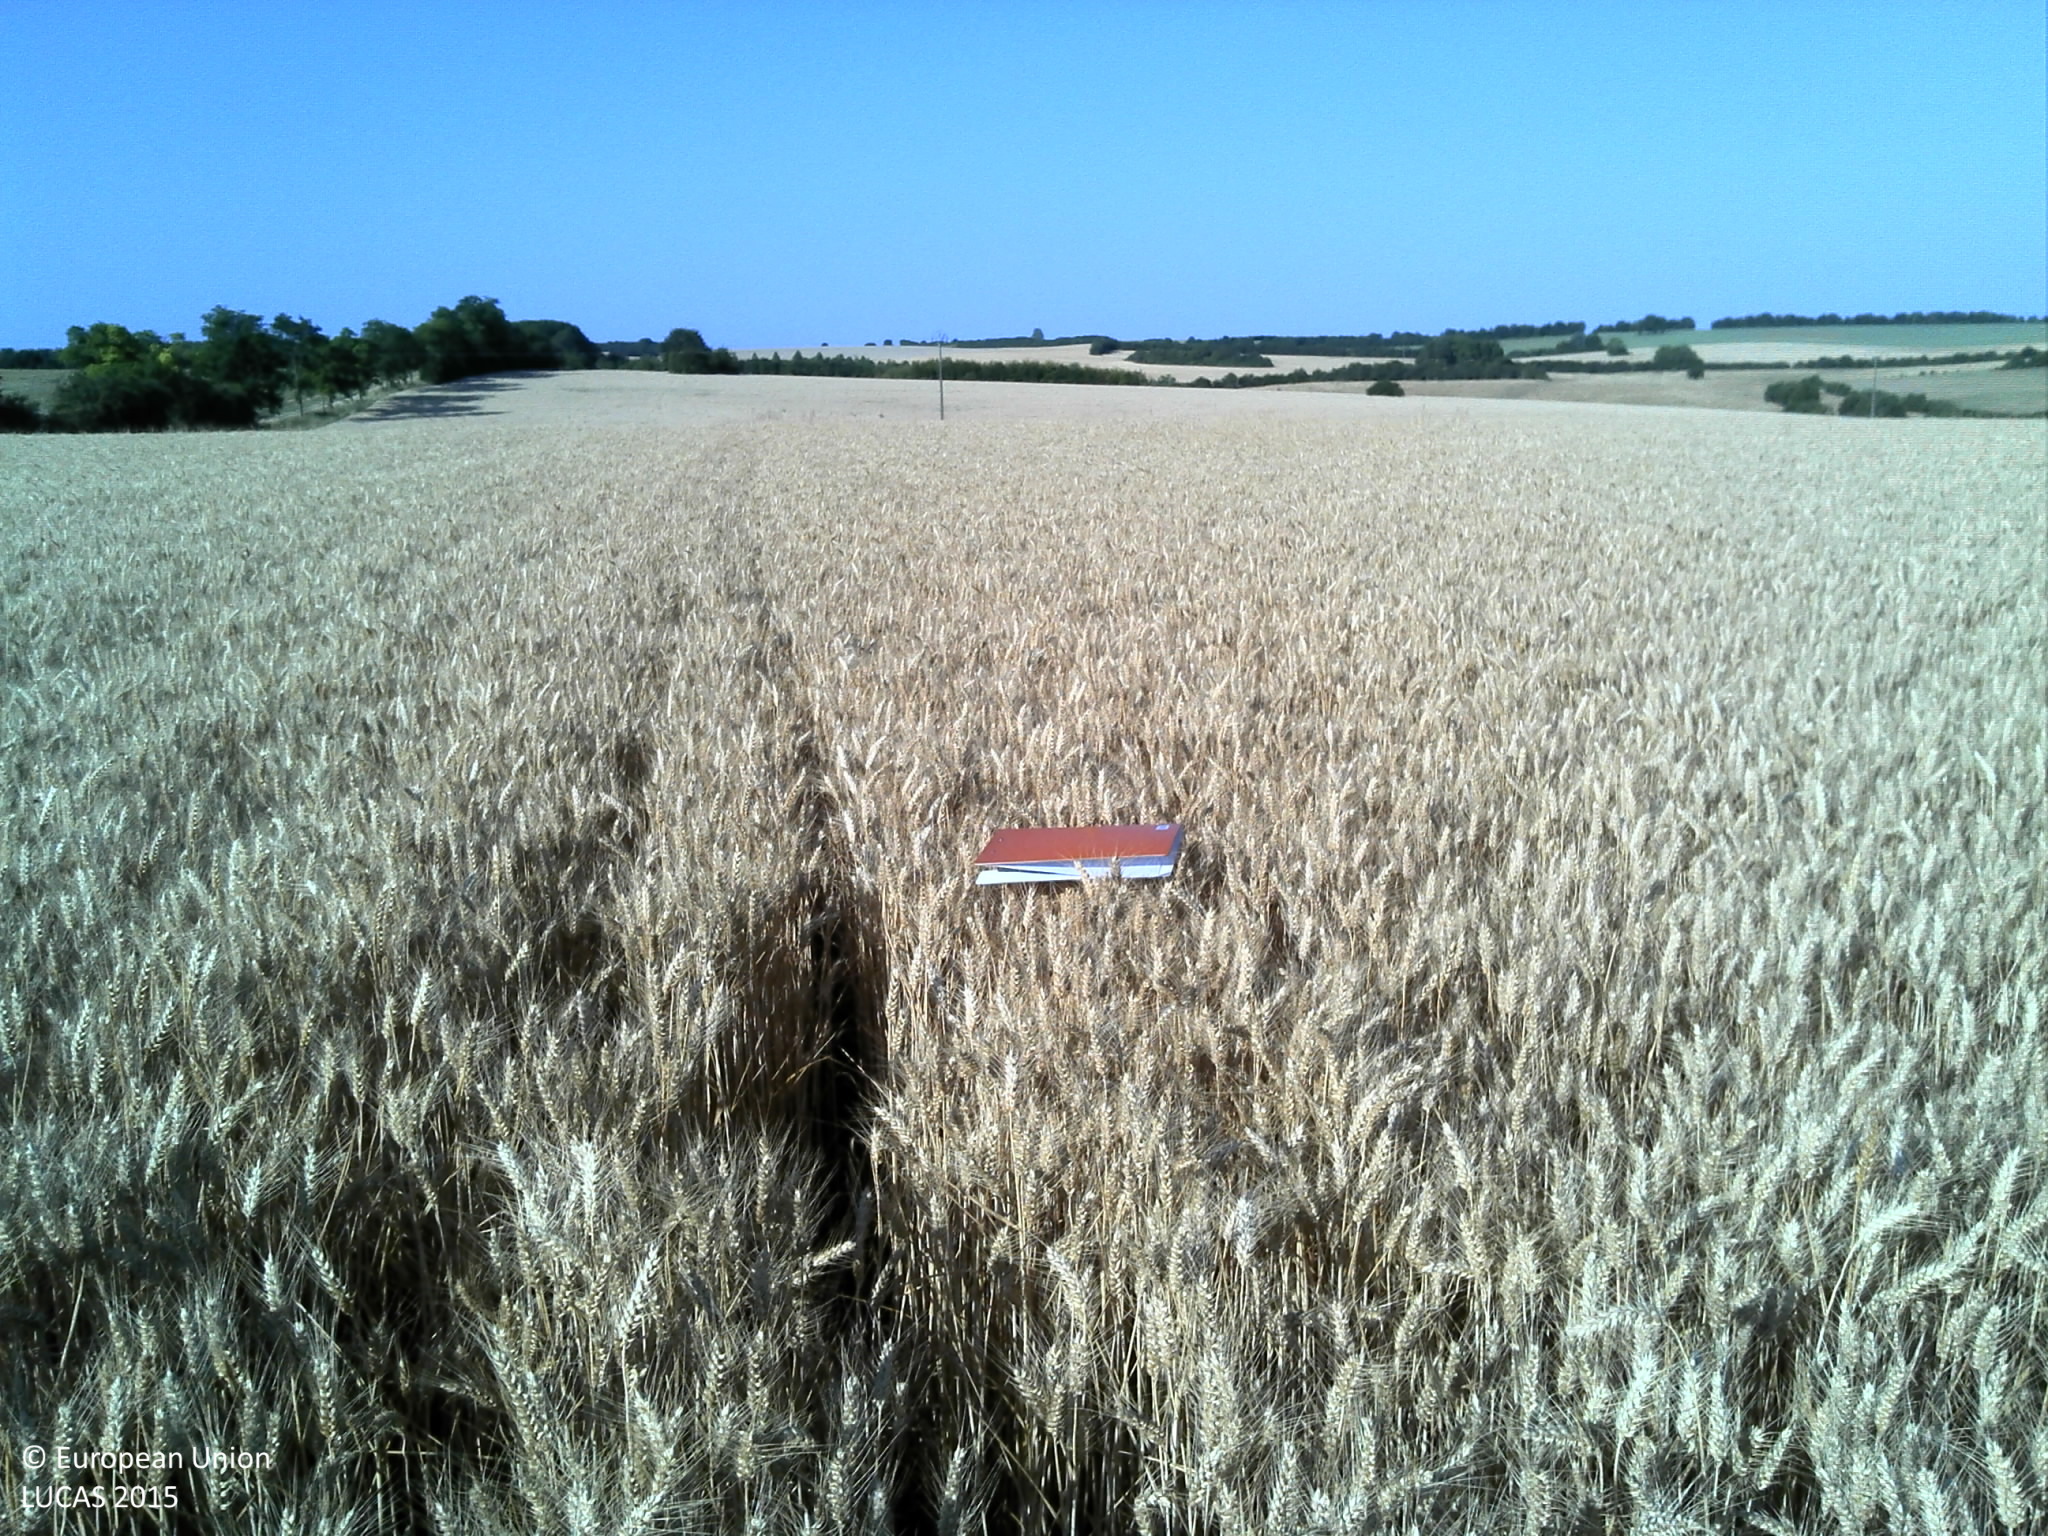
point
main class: Cropland
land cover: Durum wheat
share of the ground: > 75 %
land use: Agriculture (excluding fallow land and kitchen gardens)
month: July
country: FR
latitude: 48.1863
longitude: 5.9785
